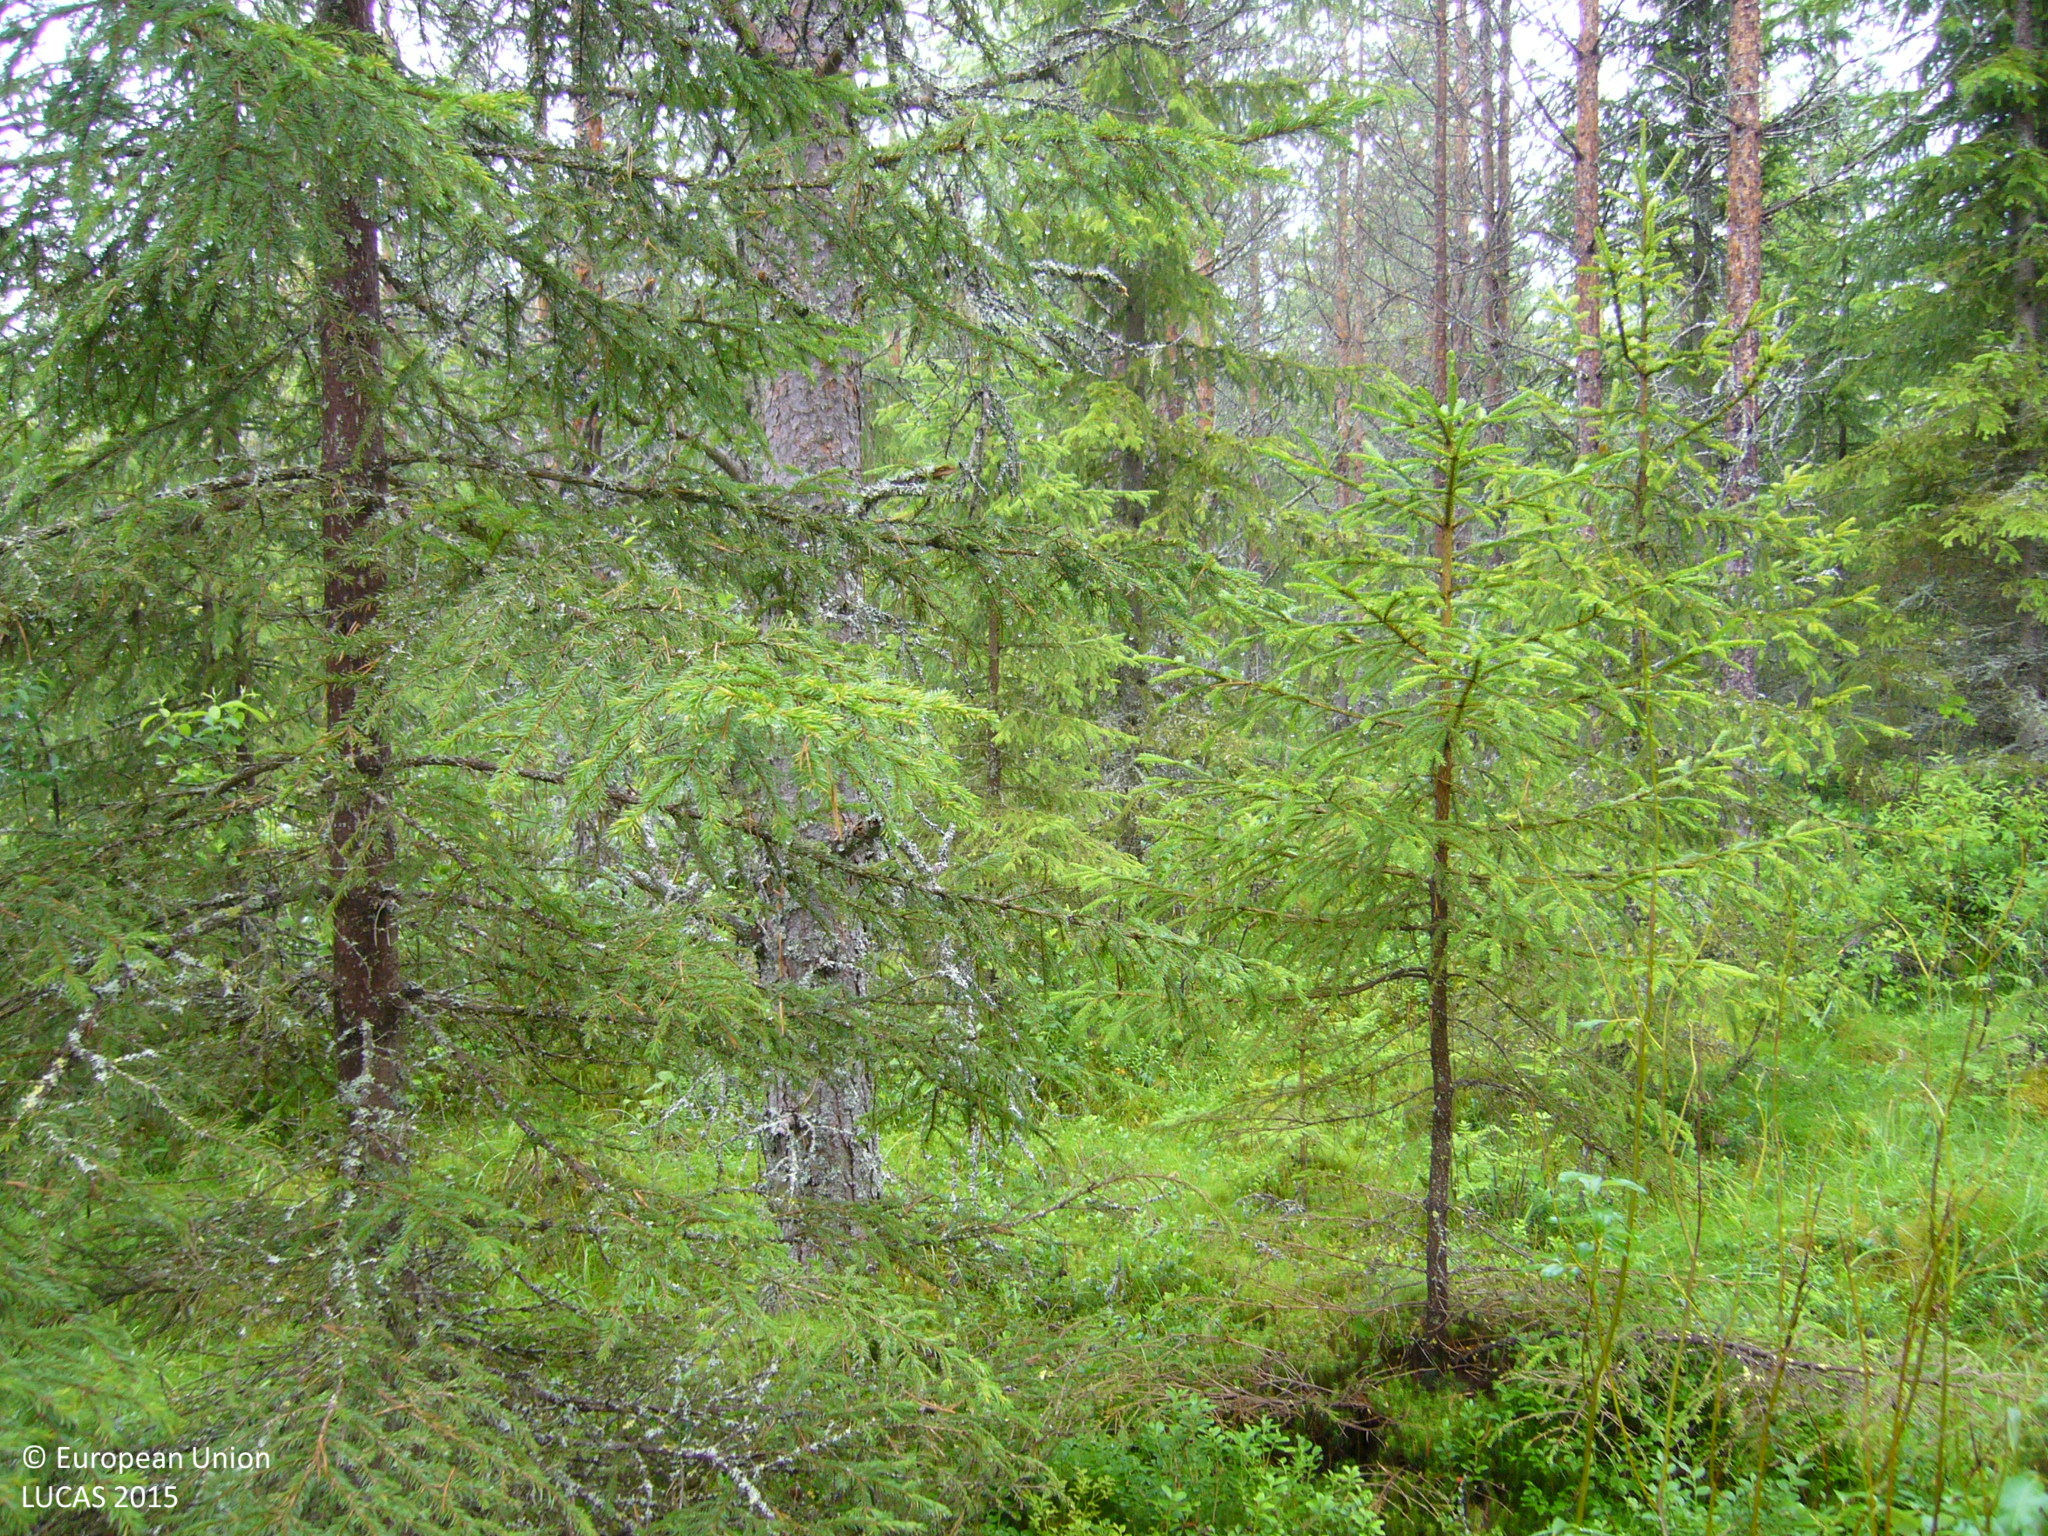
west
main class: Woodland
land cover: Pine dominated mixed woodland
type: boreal forest
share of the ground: > 75 %
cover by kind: coniferous forest trees 50 %, broadleaved forest trees 25 %, shrubs 25 %
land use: Forestry
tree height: > 5 m
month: July
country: FI
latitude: 63.8523
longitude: 26.0355
